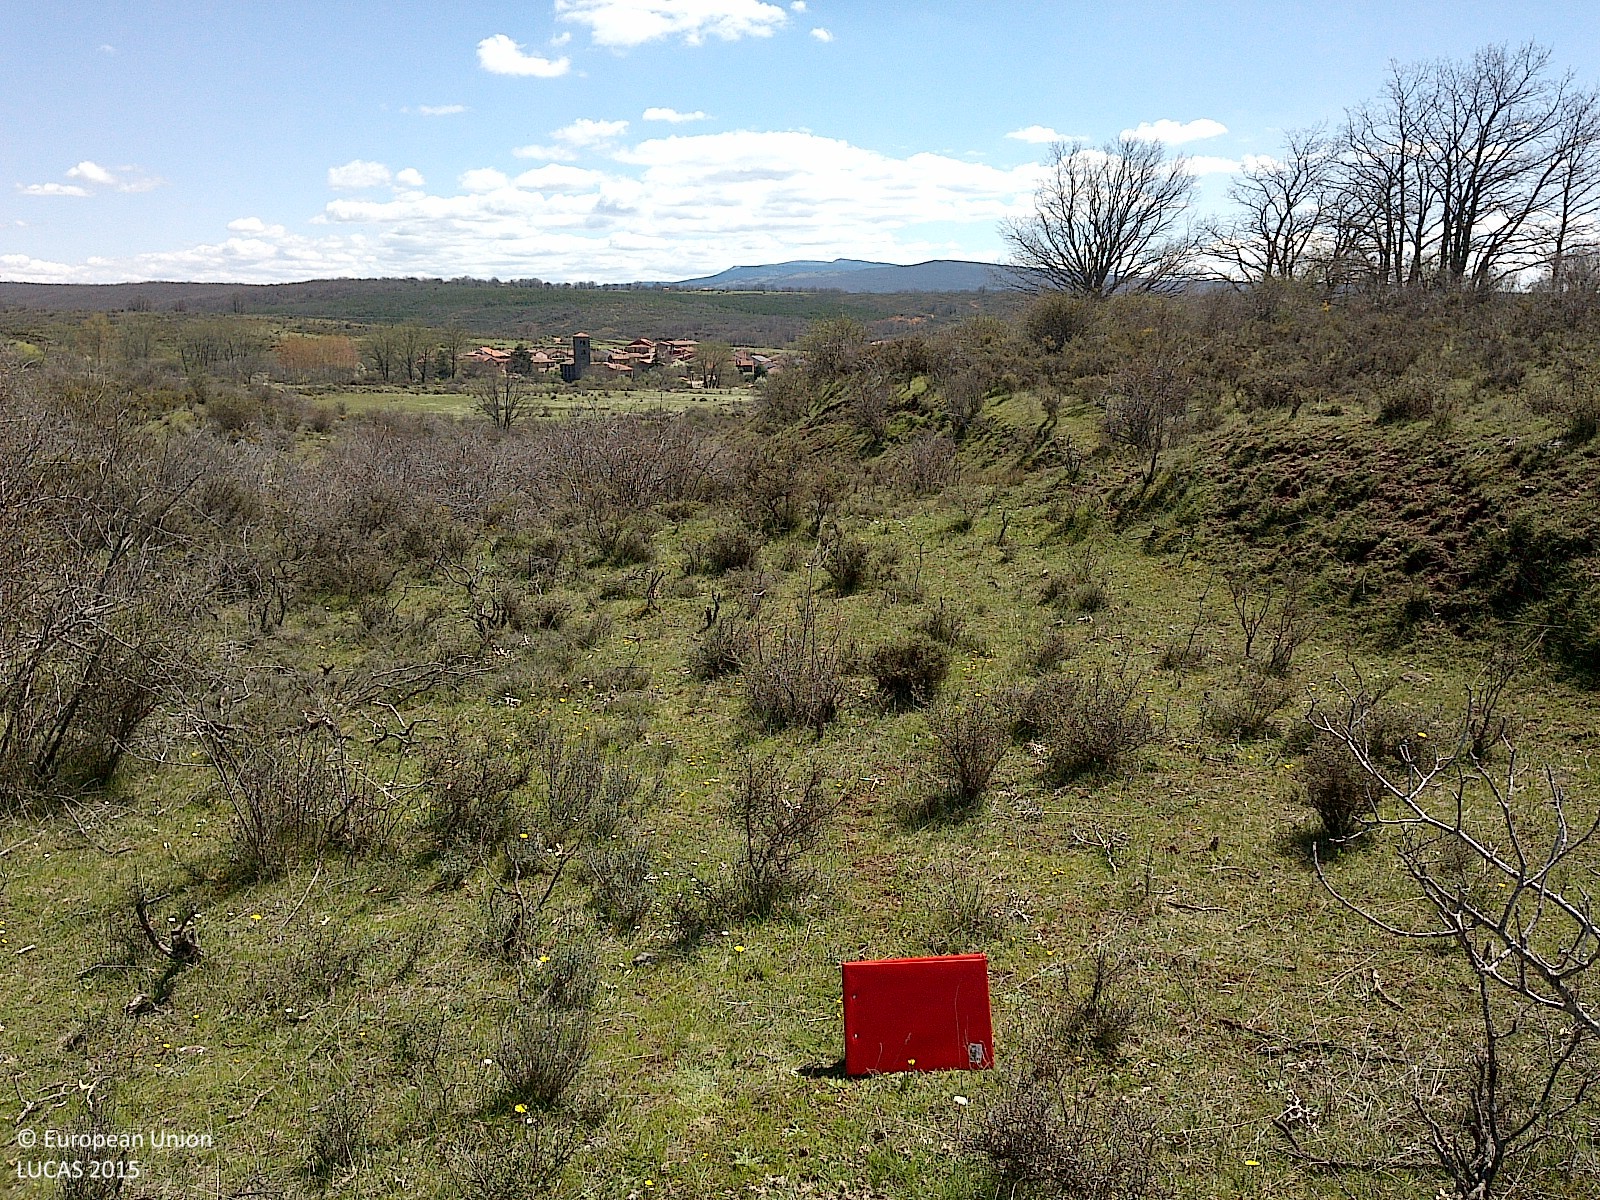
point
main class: Shrubland
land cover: Shrubland without tree cover
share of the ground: 50 - 75 %
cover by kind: shrubs 55 %, herbaceous plants 45 %
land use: Agriculture (excluding fallow land and kitchen gardens)
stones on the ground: < 10 %
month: April
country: ES
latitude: 42.1171
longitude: -3.3208
